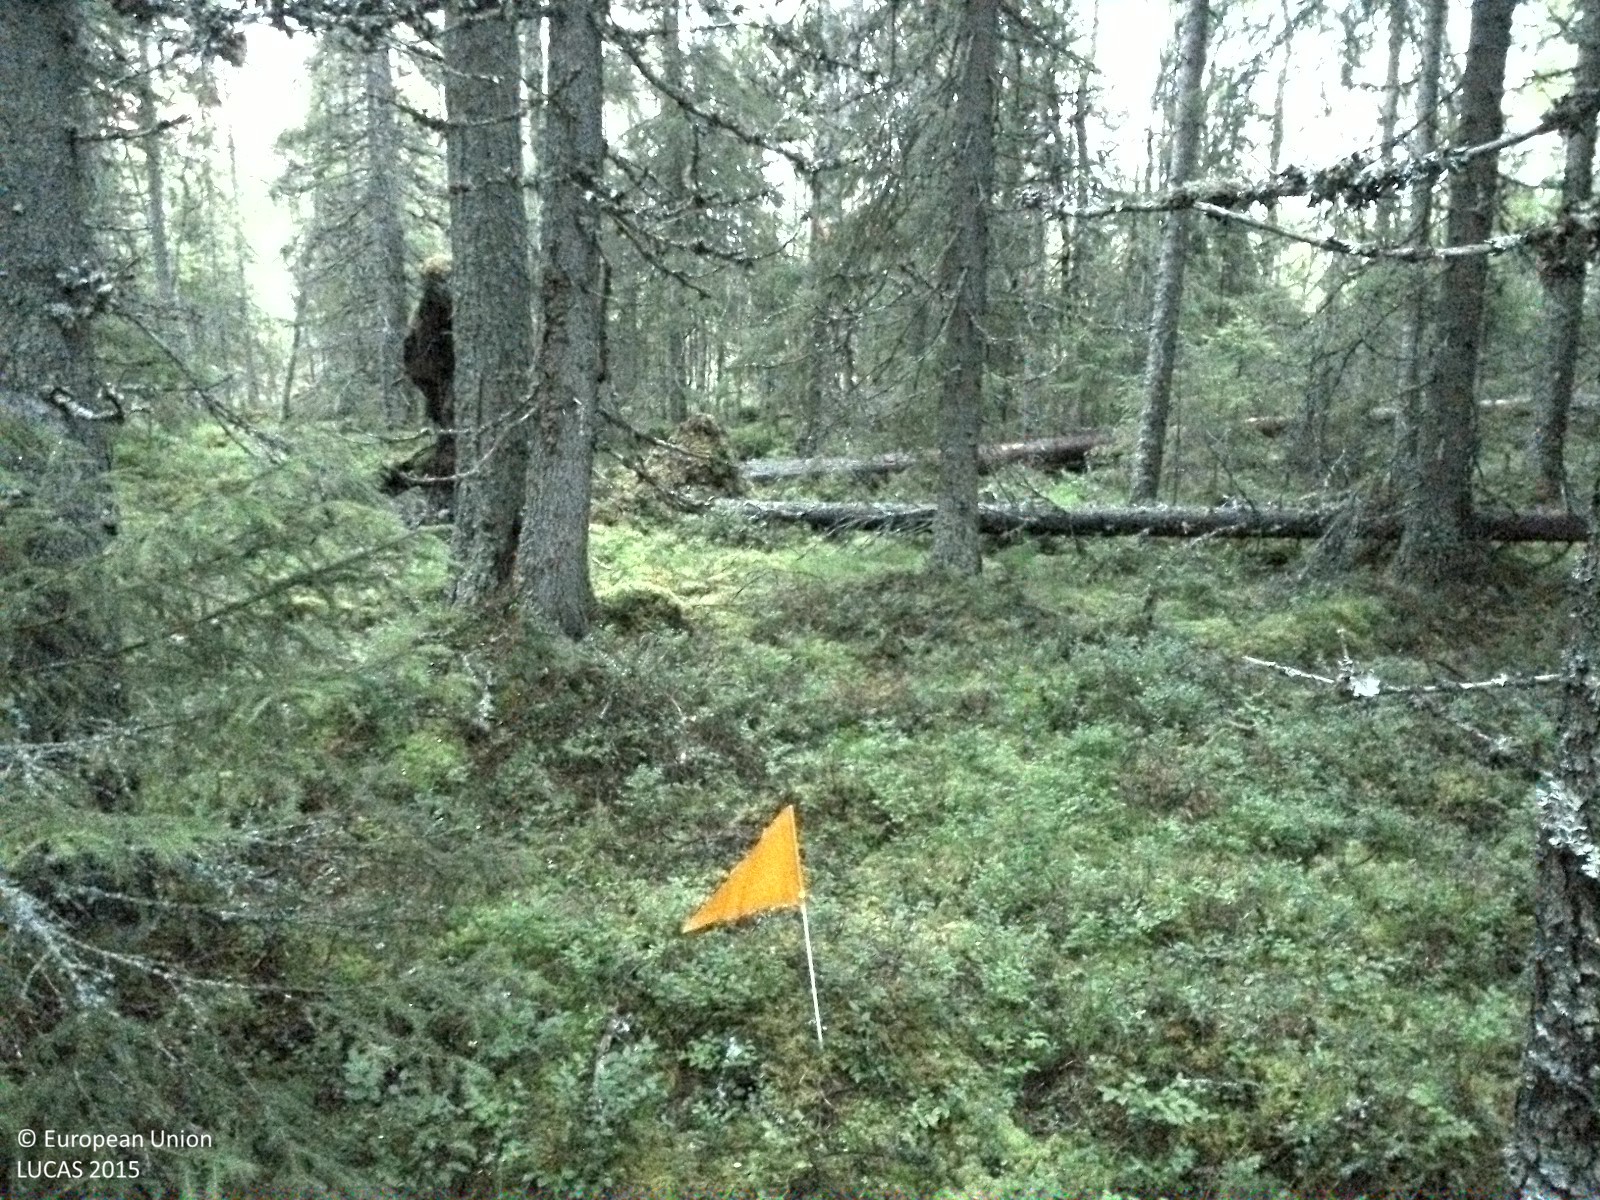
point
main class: Woodland
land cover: Spruce dominated coniferous woodland
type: boreal forest
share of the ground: 50 - 75 %
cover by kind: coniferous forest trees 70 %, shrubs 20 %, lichens and mosses 10 %
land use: Forestry
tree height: > 5 m
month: August
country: SE
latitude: 62.6263
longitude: 16.2754
